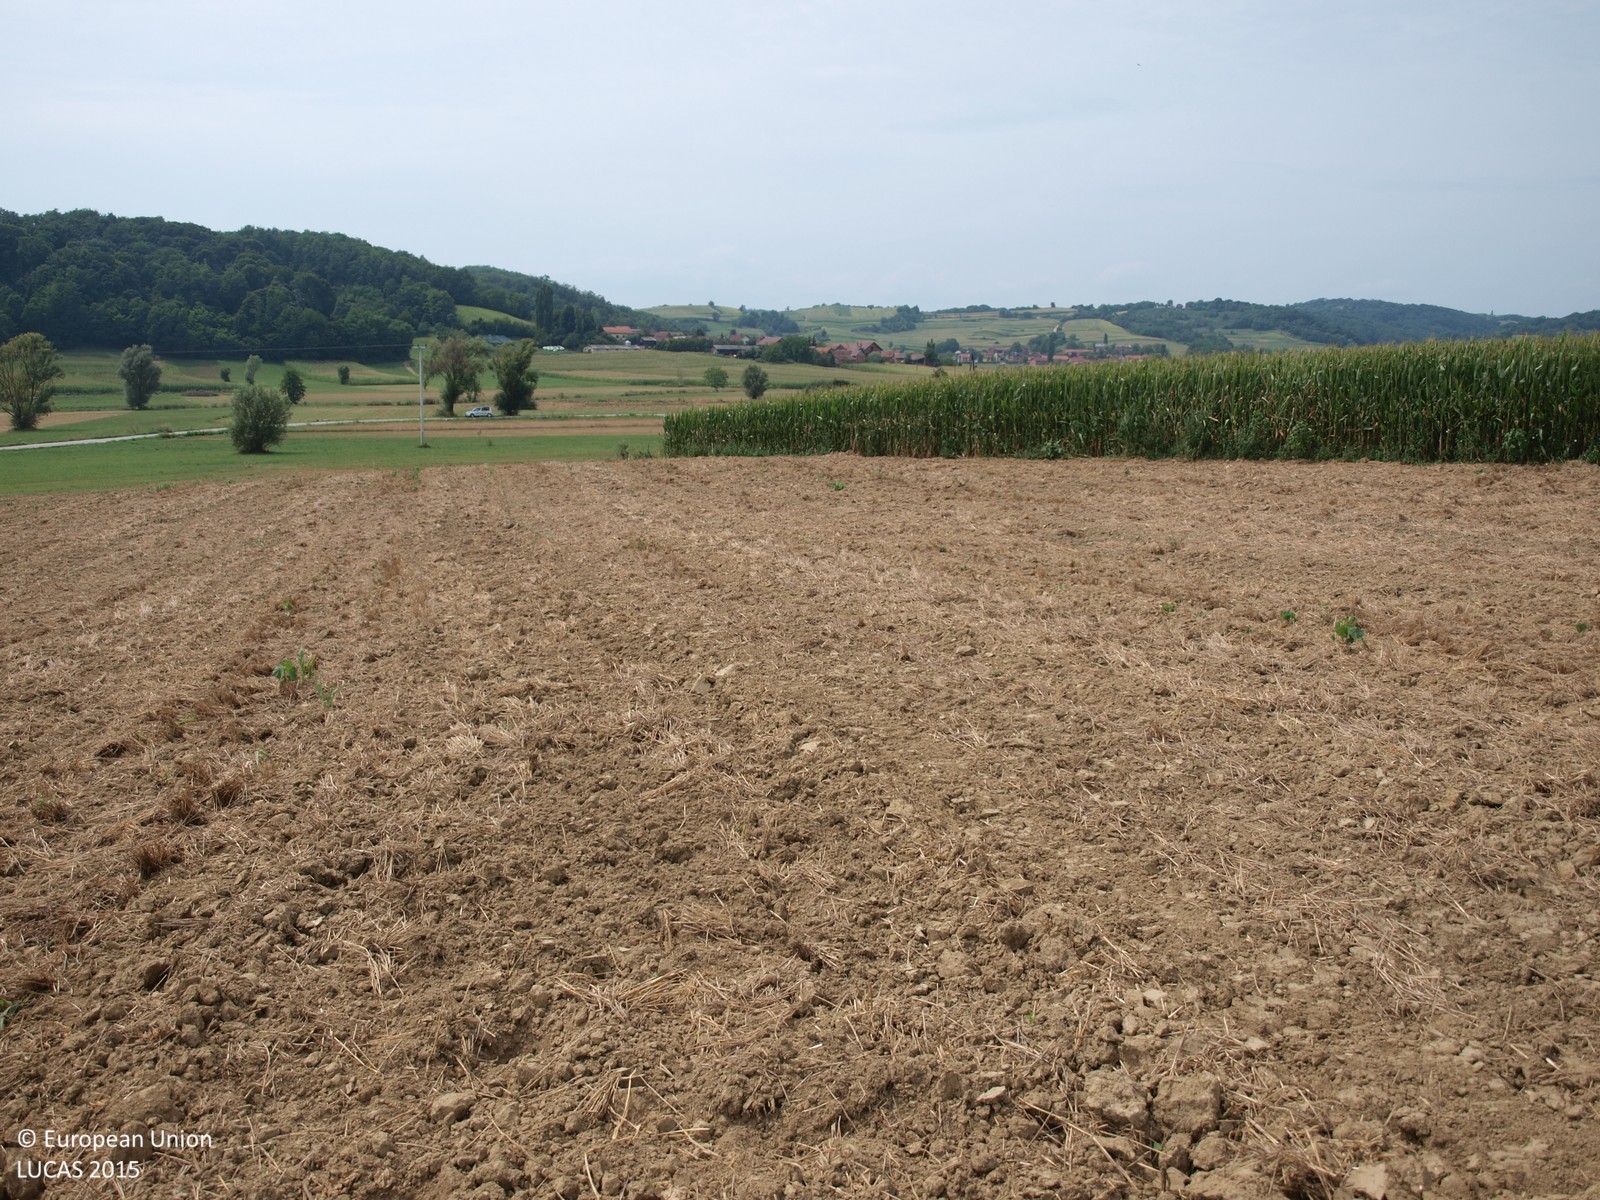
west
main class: Cropland
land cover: Barley
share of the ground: > 75 %
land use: Agriculture (excluding fallow land and kitchen gardens)
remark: Harvested field
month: August
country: HR
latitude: 46.0513
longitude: 16.3971
